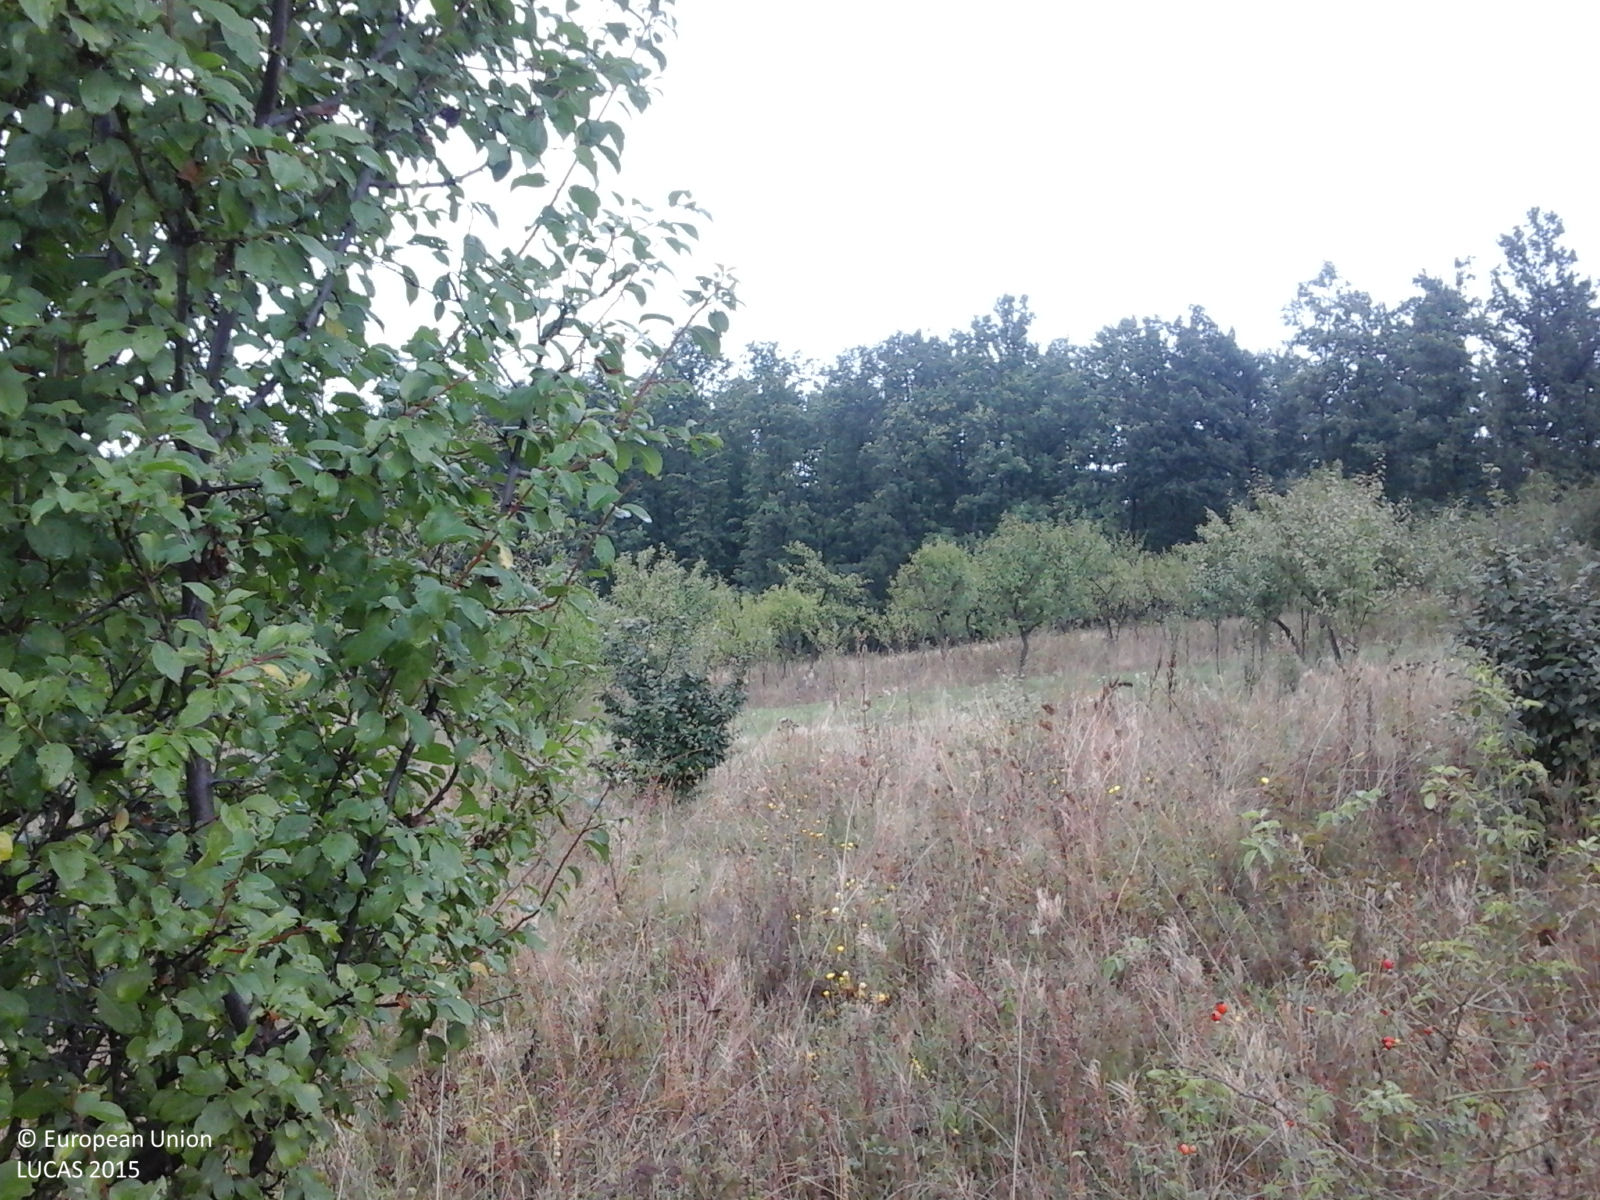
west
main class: Grassland
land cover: Grassland with sparse tree/shrub cover
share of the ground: > 75 %
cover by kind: herbaceous plants 85 %, shrubs 10 %, broadleaved forest trees 5 %
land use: Agriculture (excluding fallow land and kitchen gardens)
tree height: < 5 m
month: September
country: RO
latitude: 47.2758
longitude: 22.4681
